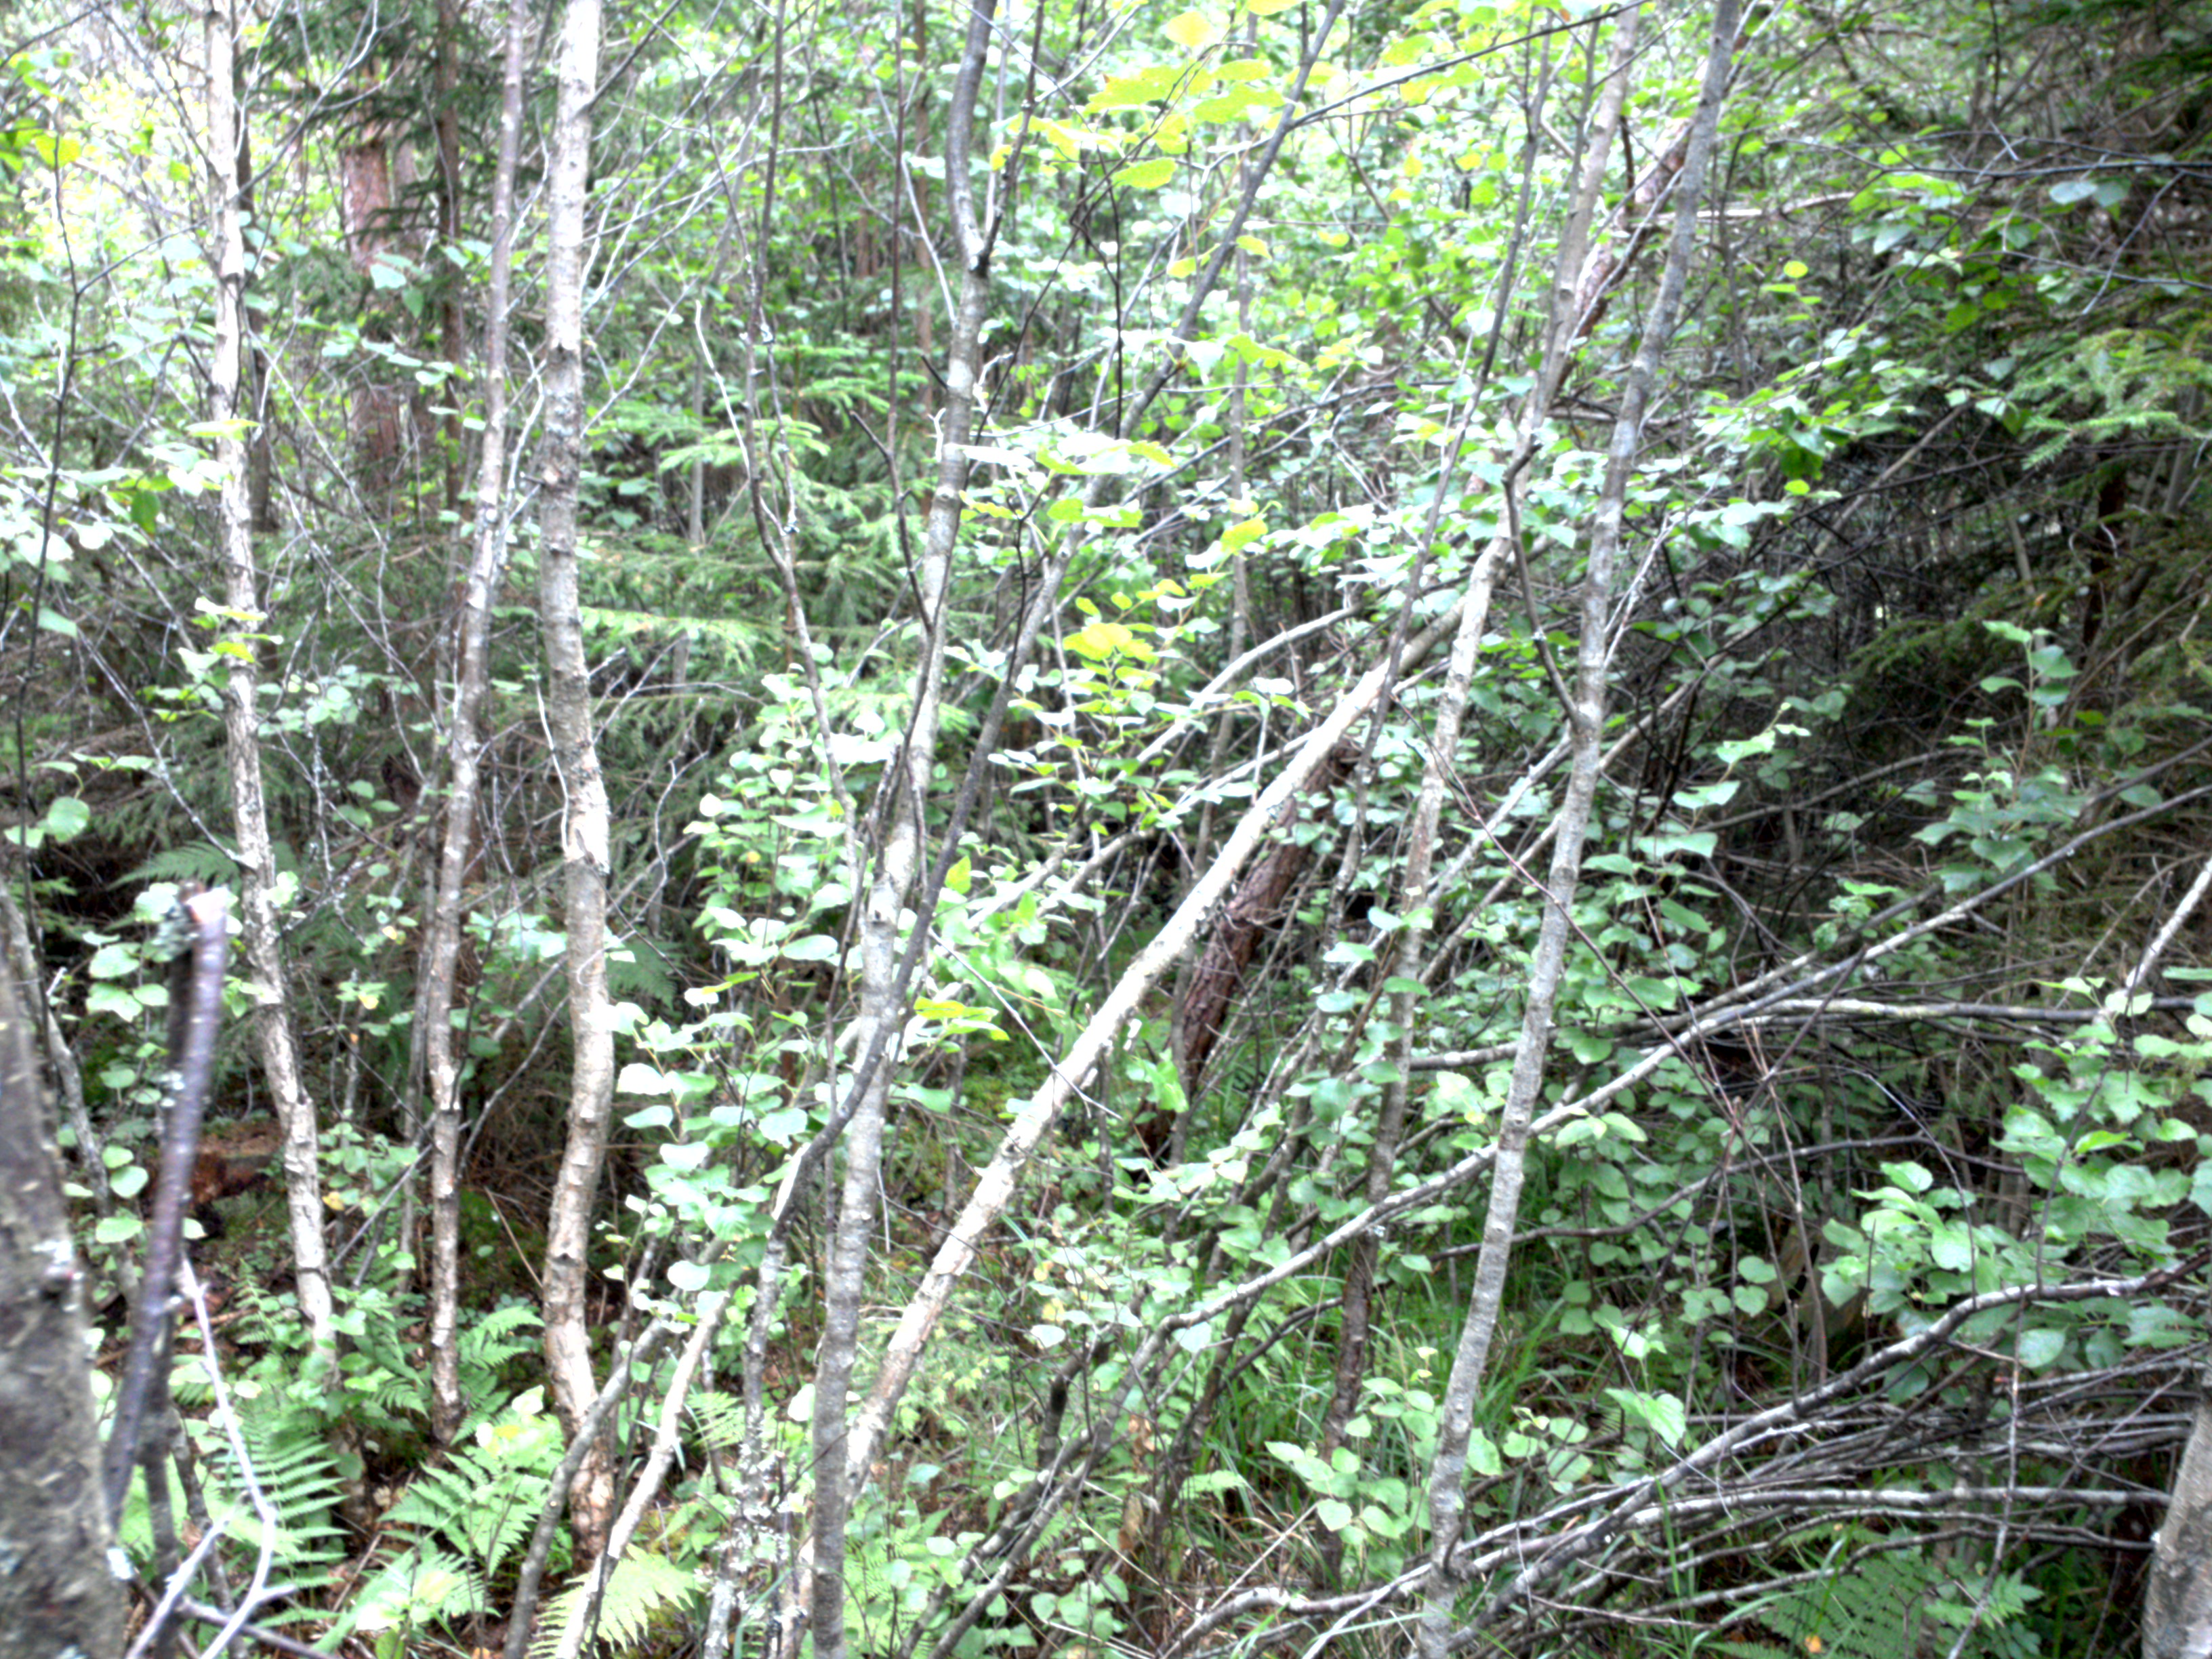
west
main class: Woodland
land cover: Spruce dominated mixed woodland
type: boreal forest
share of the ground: > 75 %
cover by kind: coniferous forest trees 50 %, broadleaved forest trees 40 %, herbaceous plants 5 %, lichens and mosses 5 %
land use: Forestry
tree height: > 5 m
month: July
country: SE
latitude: 59.1505
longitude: 18.4110
